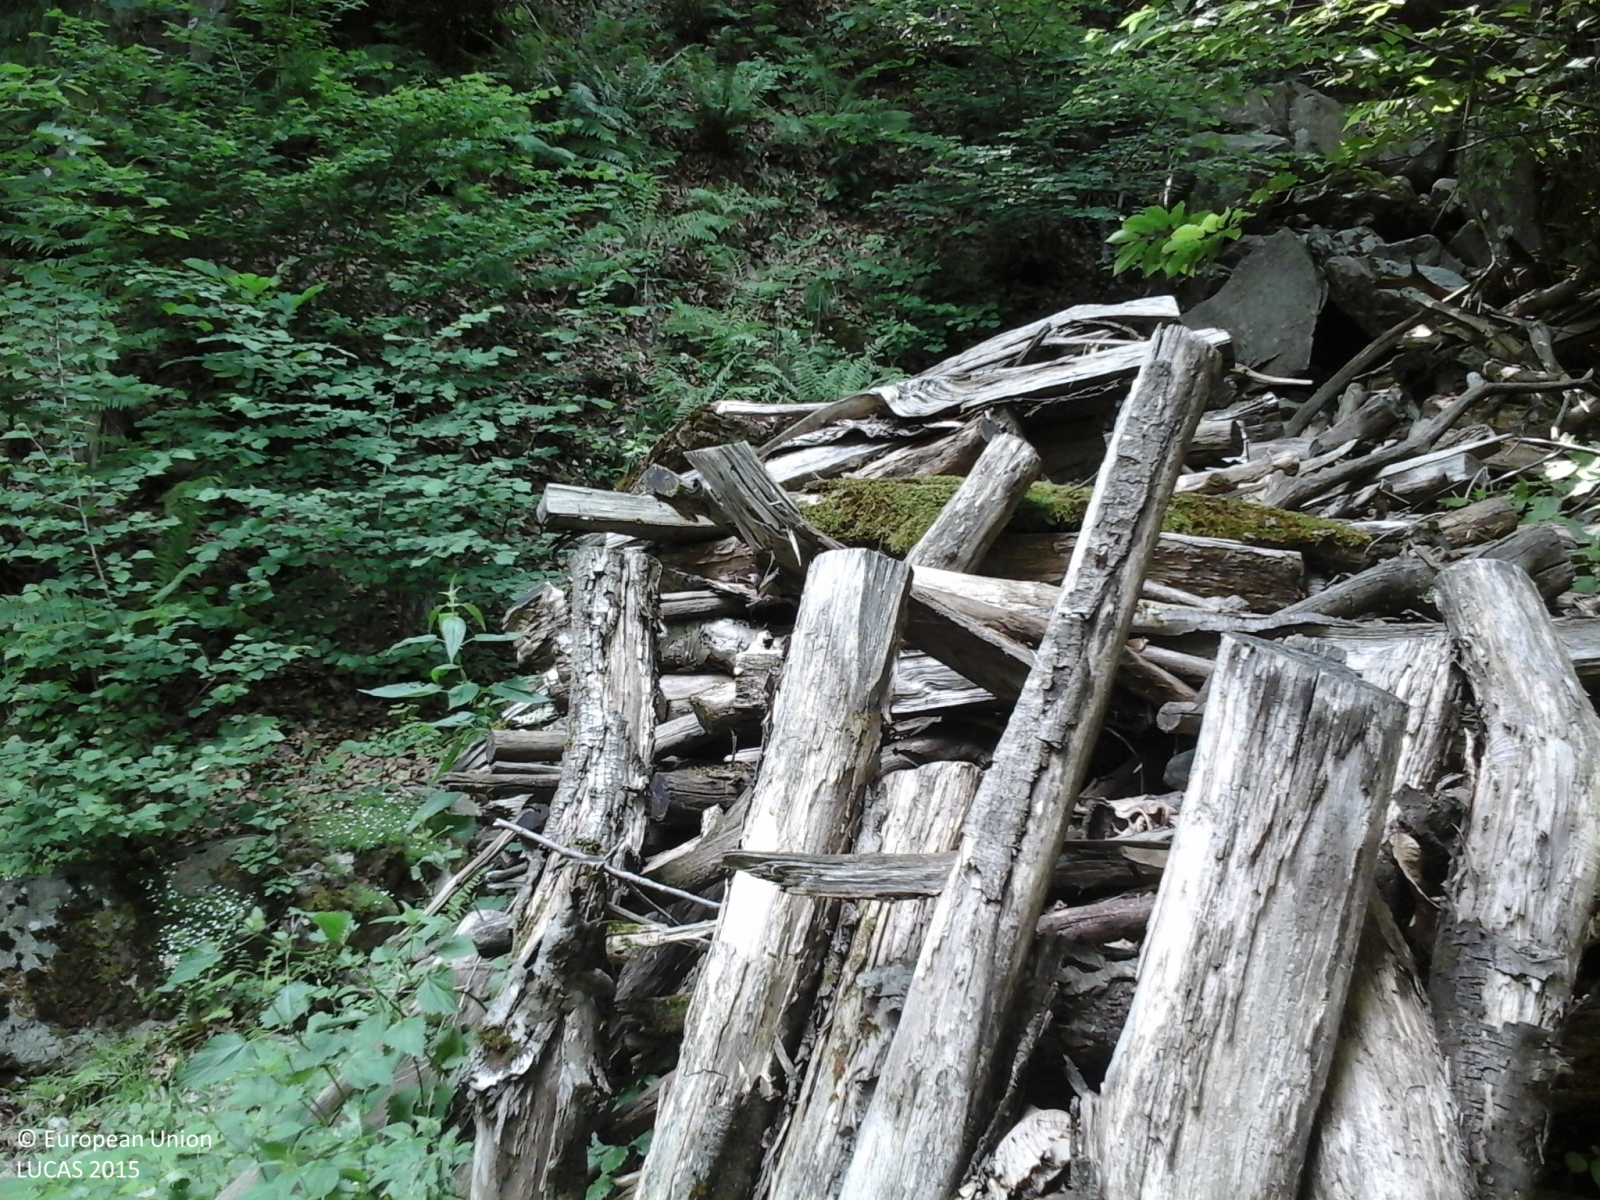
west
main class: Woodland
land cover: Broadleaved woodland
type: beech forest
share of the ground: > 75 %
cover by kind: broadleaved forest trees 100 %
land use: Forestry
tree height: > 5 m
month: June
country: IT
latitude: 45.8682
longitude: 8.2377
